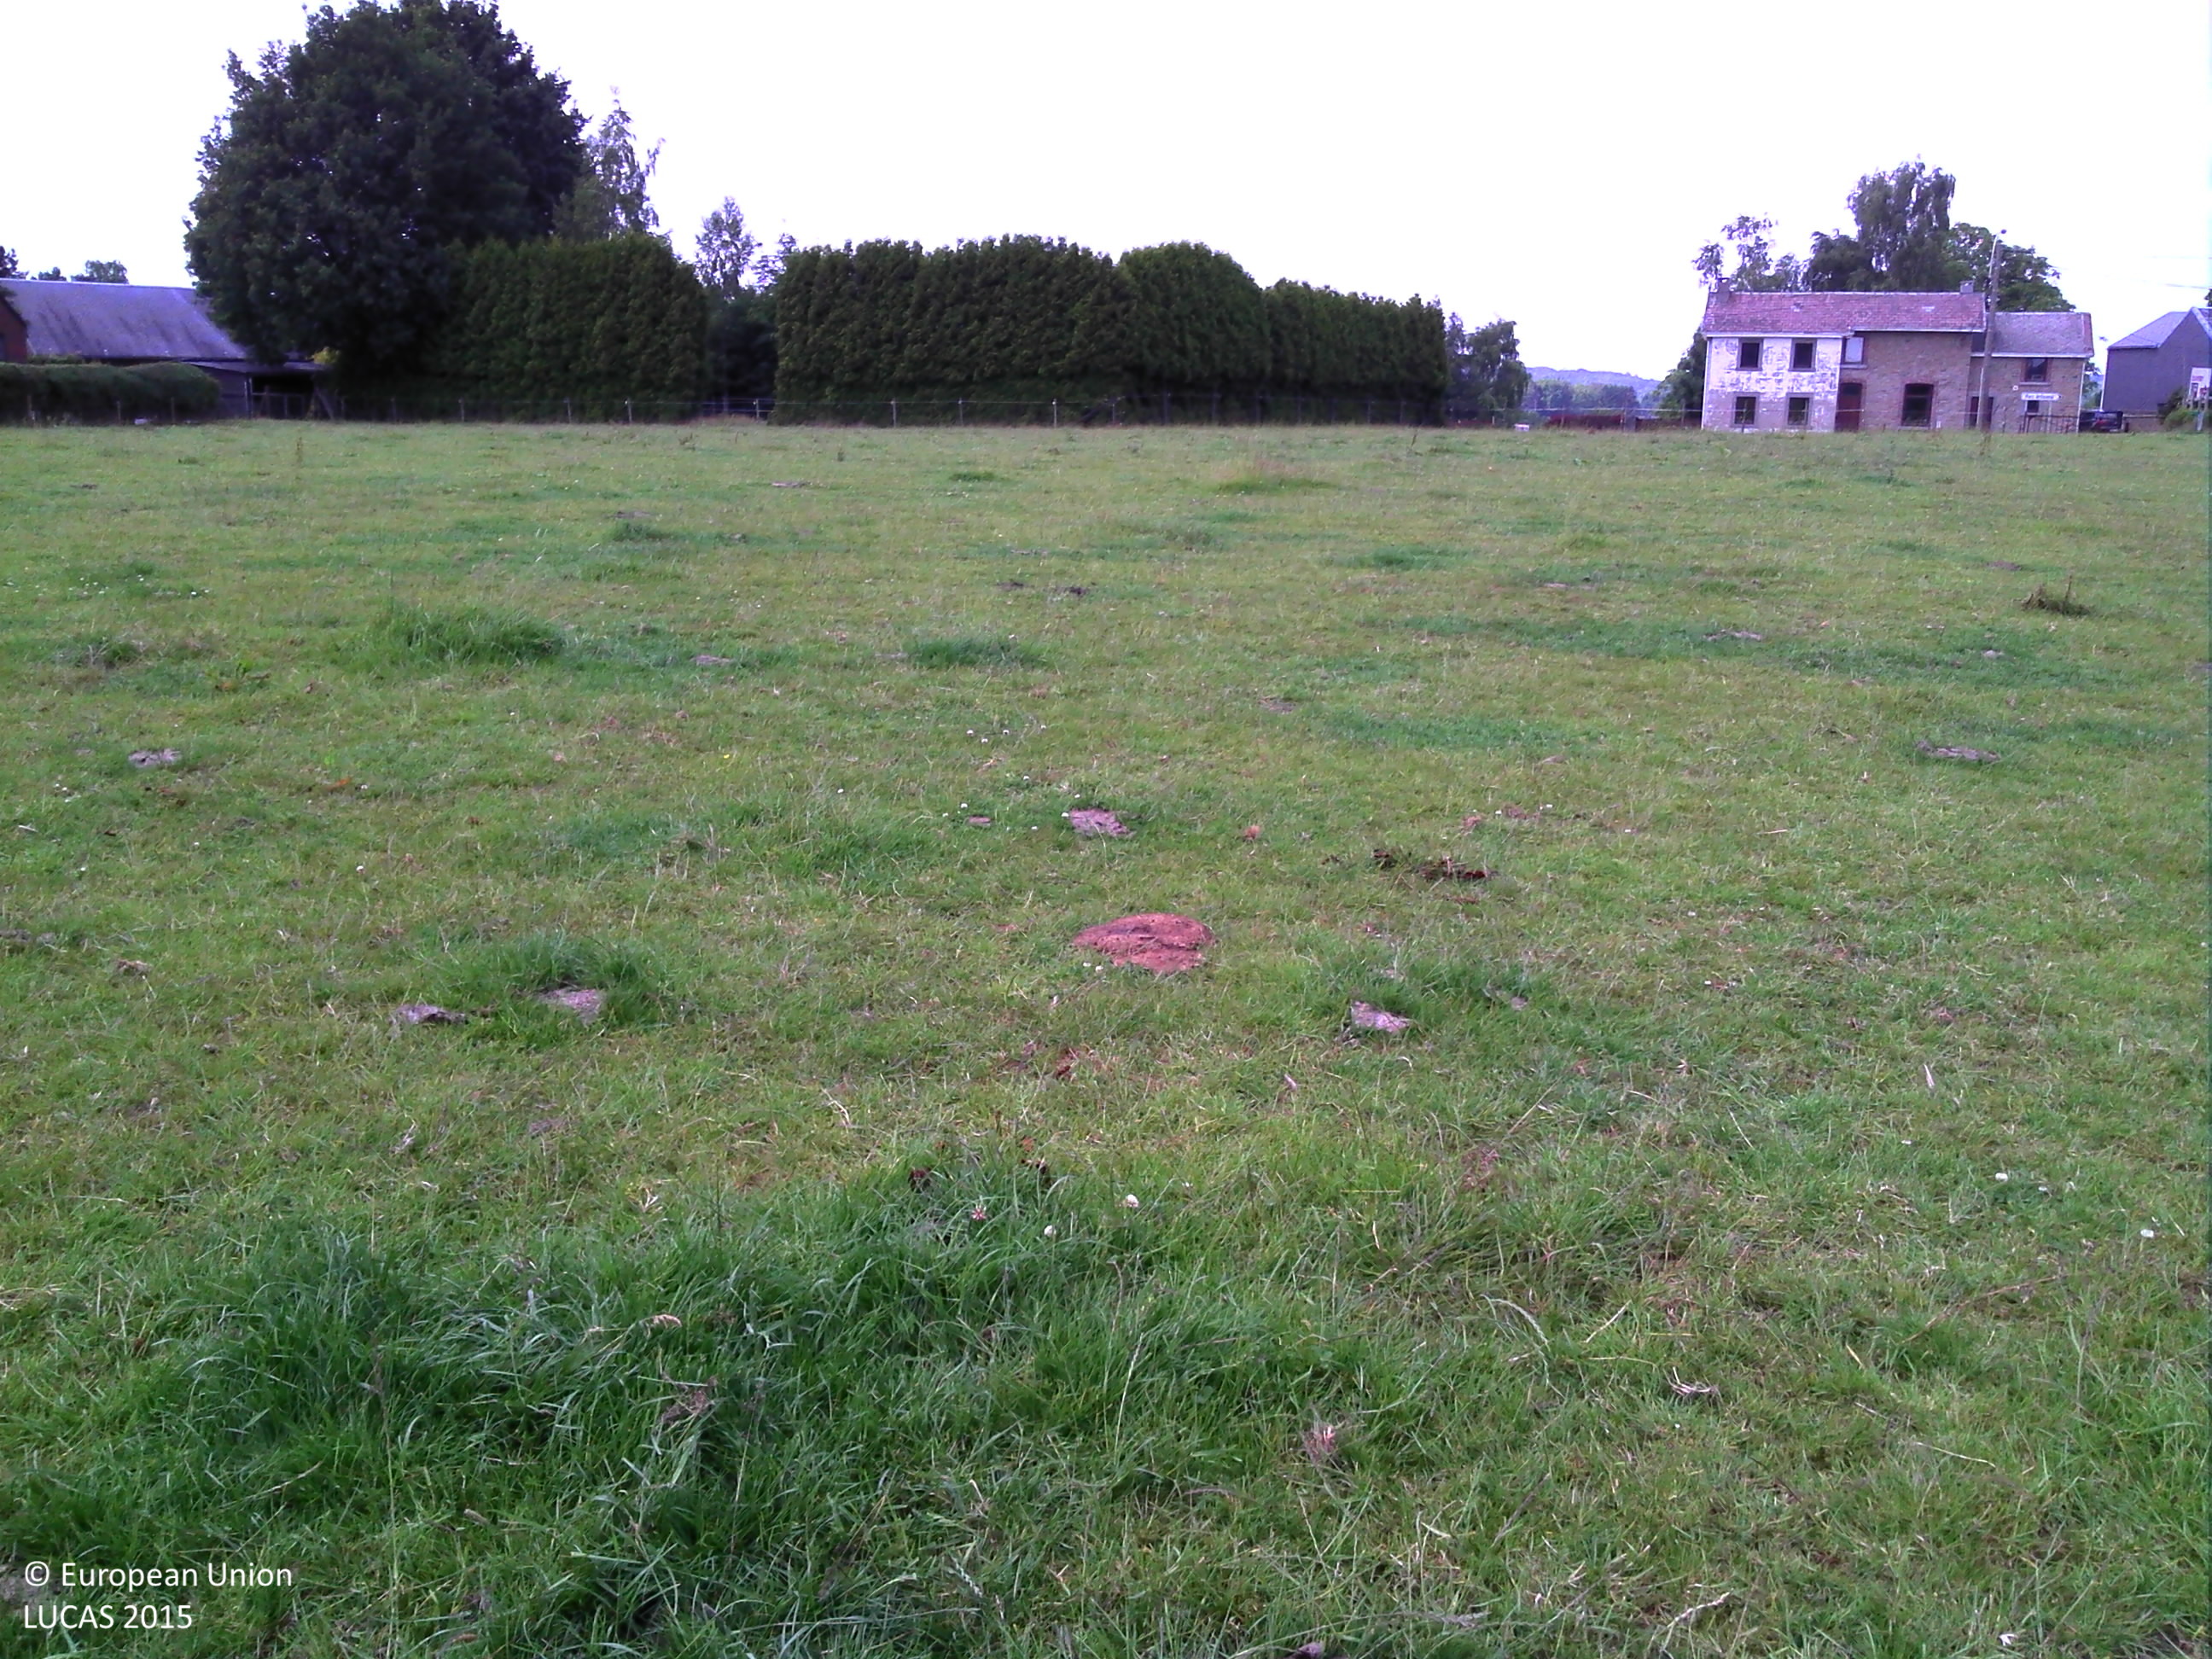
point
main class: Grassland
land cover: Grassland without tree/shrub cover
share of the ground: > 75 %
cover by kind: herbaceous plants 100 %
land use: Agriculture (excluding fallow land and kitchen gardens)
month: June
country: BE
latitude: 50.4368
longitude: 5.4787
